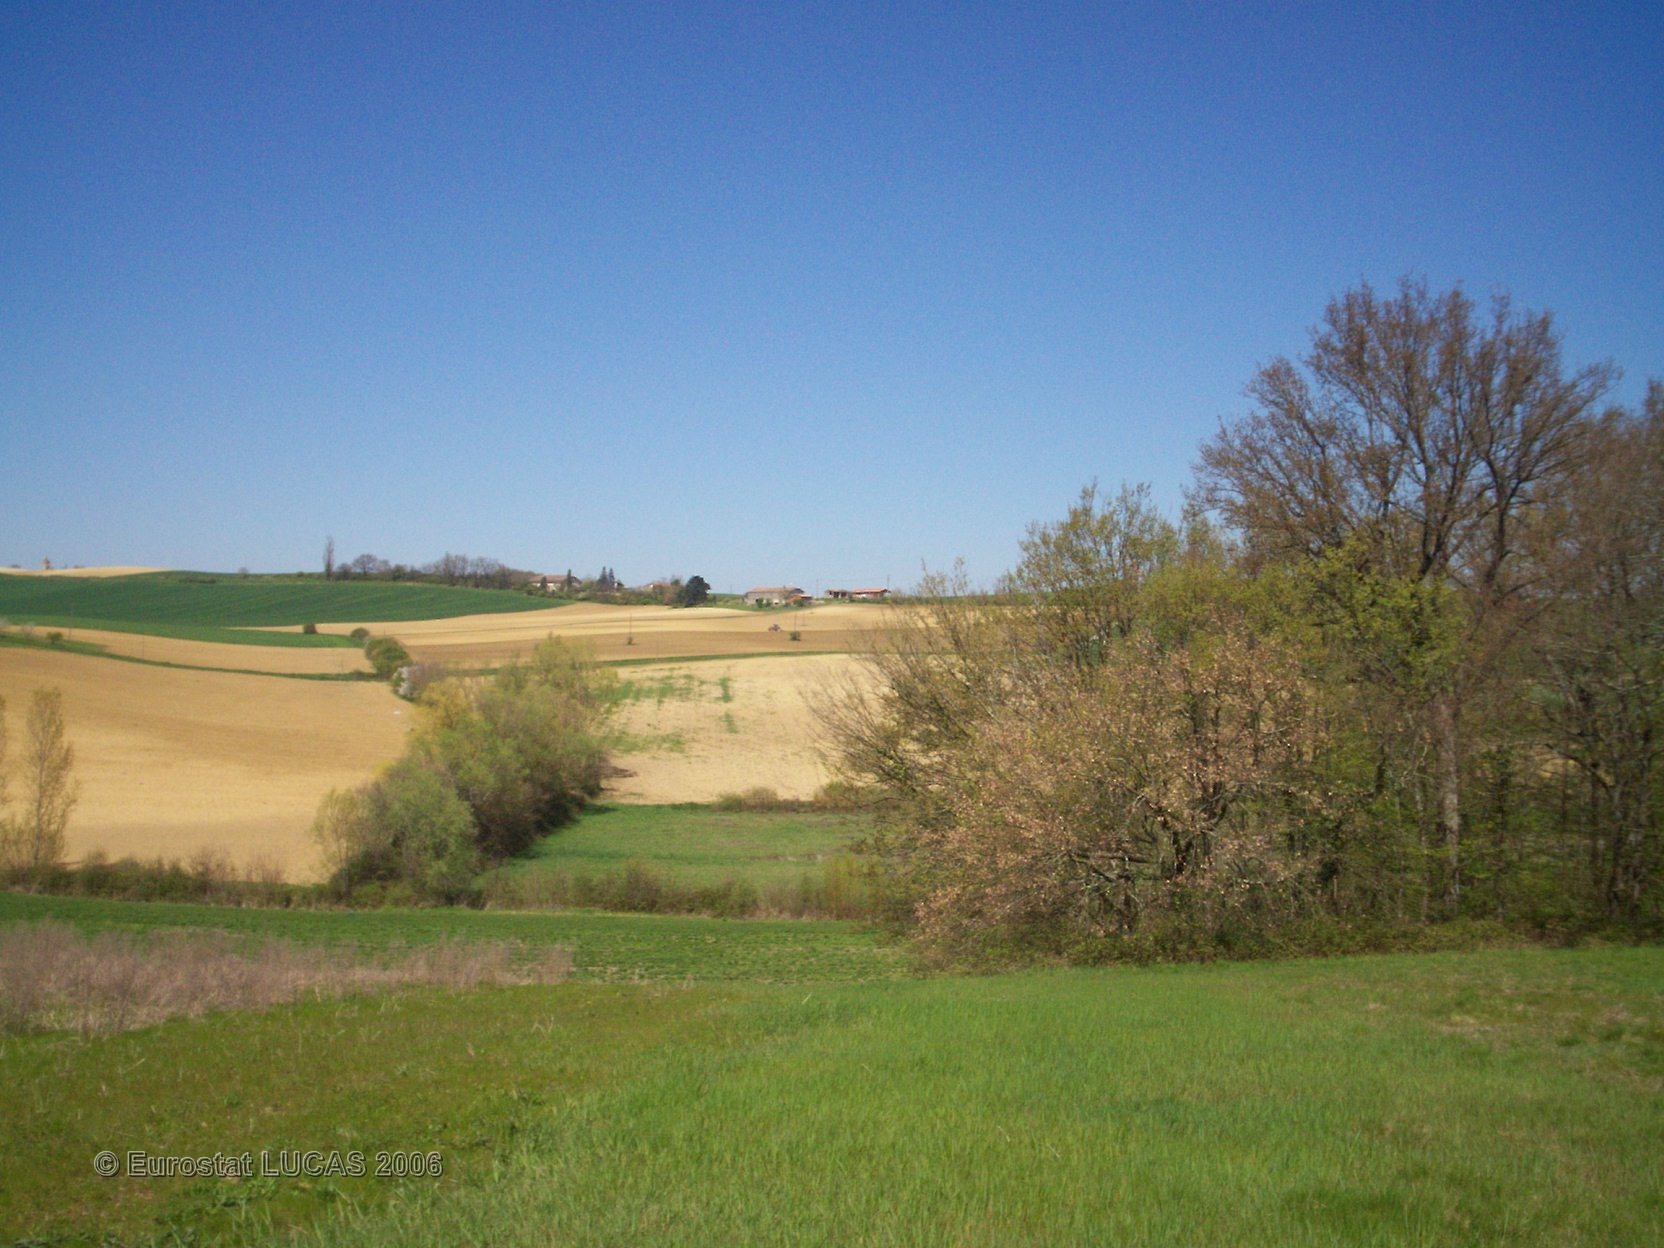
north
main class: Grassland
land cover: Grassland without tree/shrub cover
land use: Agriculture (excluding fallow land and kitchen gardens)
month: April
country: FR
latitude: 43.8618
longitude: 0.9282
